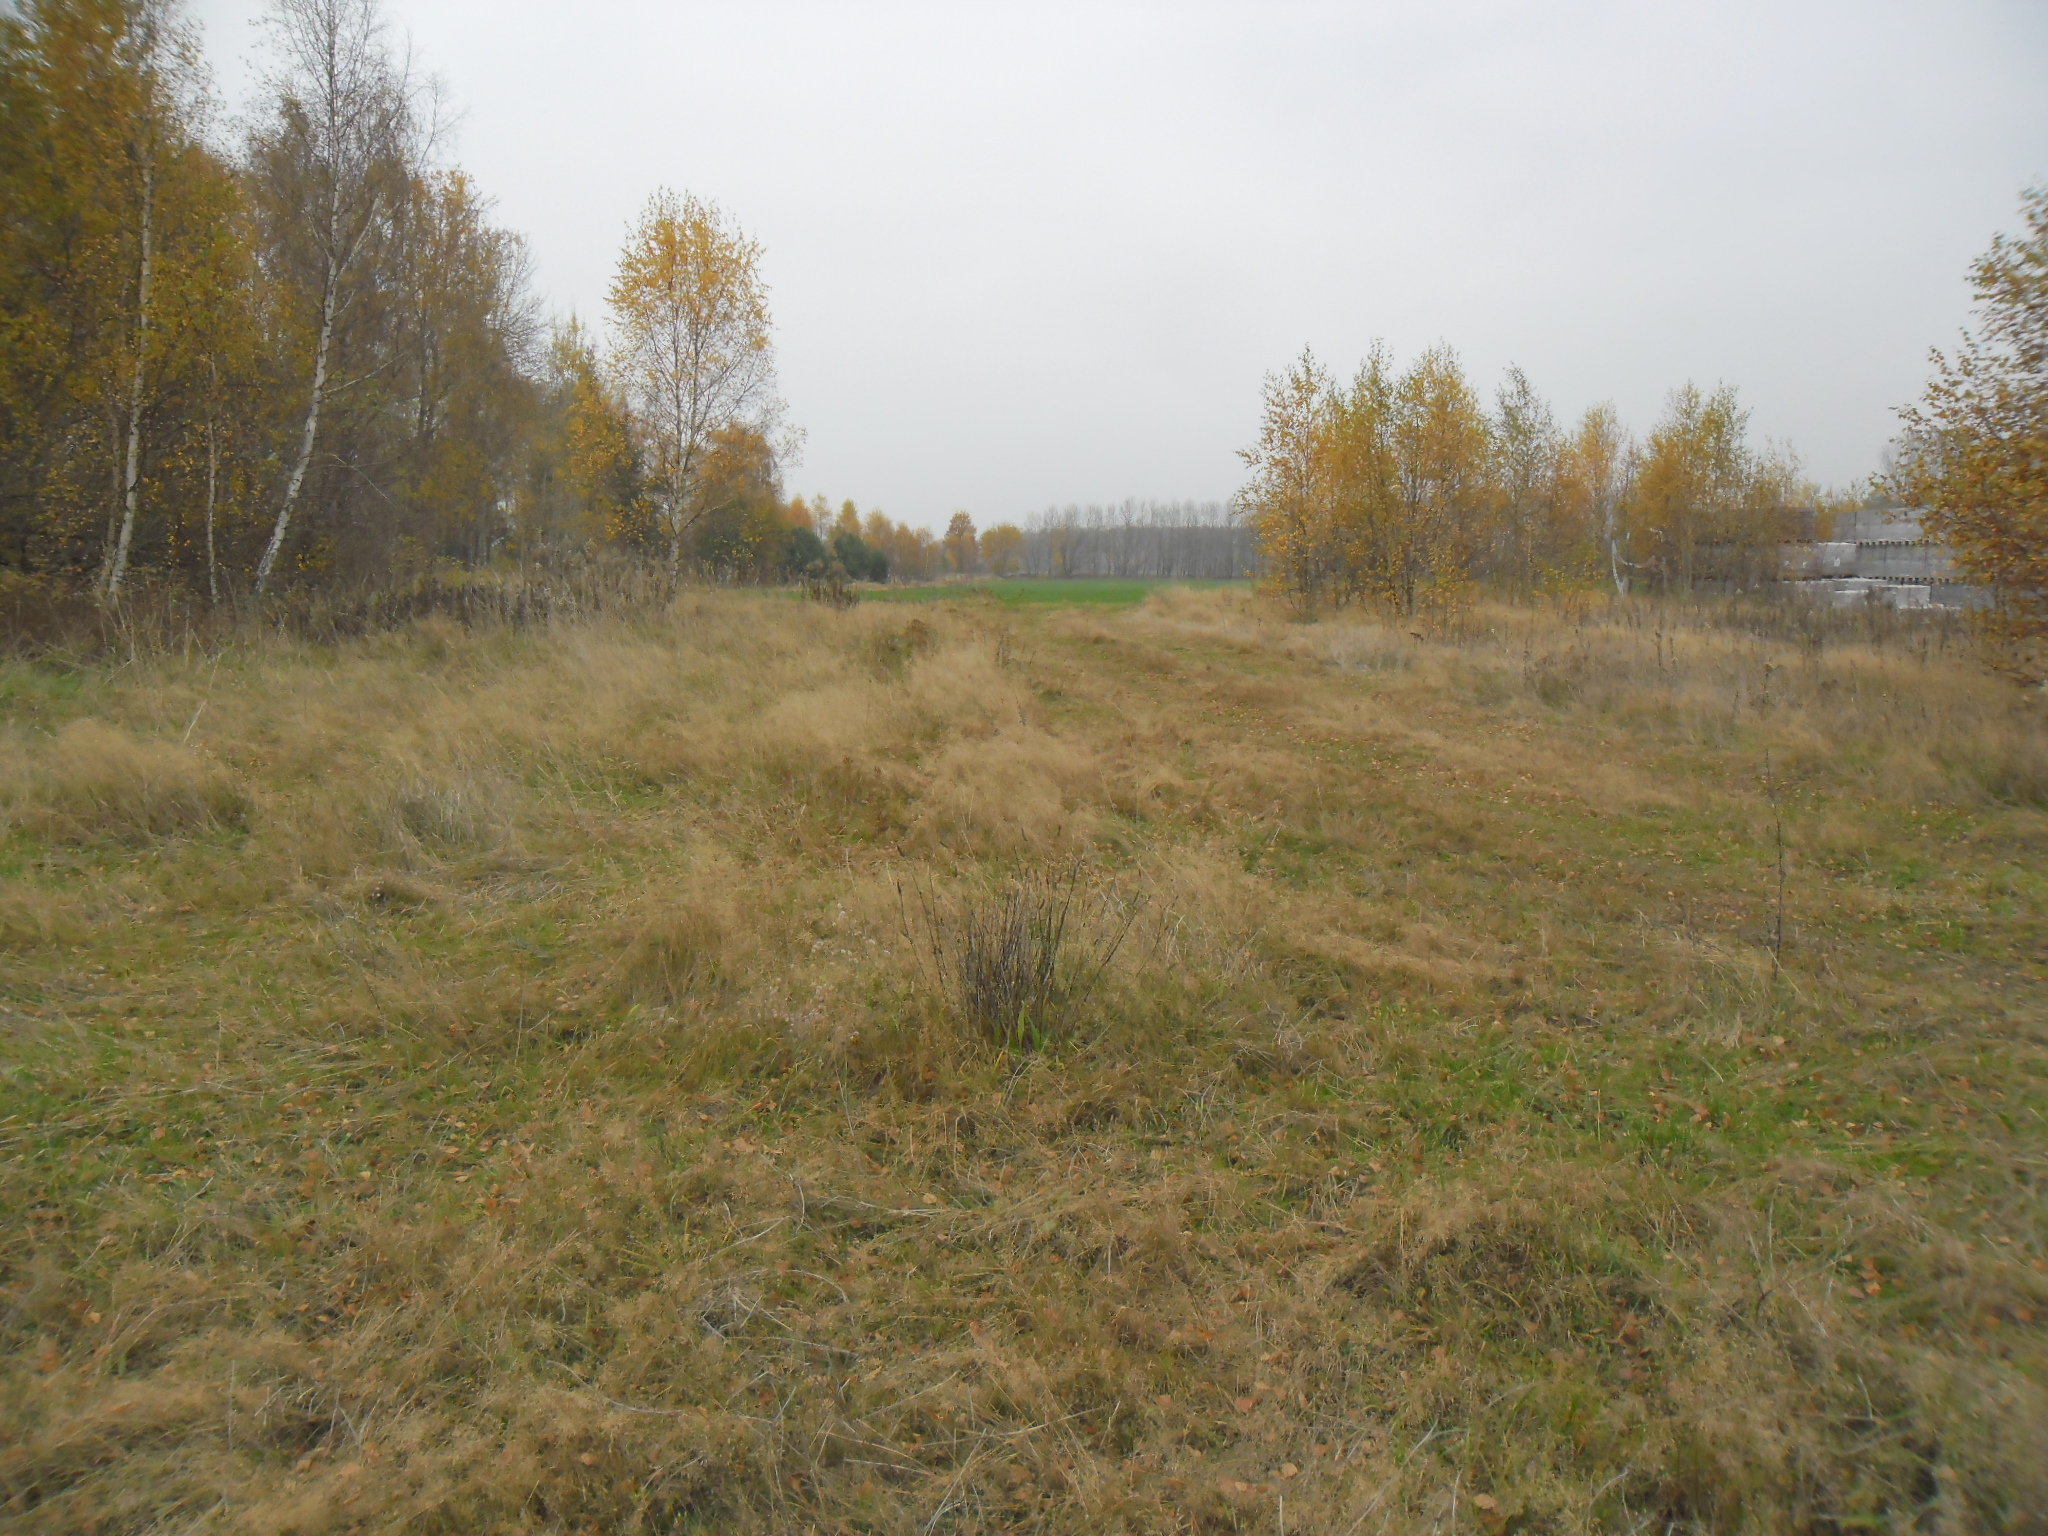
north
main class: Grassland
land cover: Grassland without tree/shrub cover
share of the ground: > 75 %
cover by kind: herbaceous plants 100 %
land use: Agriculture (excluding fallow land and kitchen gardens)
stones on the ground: 10 - 25 %
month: October
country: SE
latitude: 56.4196
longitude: 13.1258
